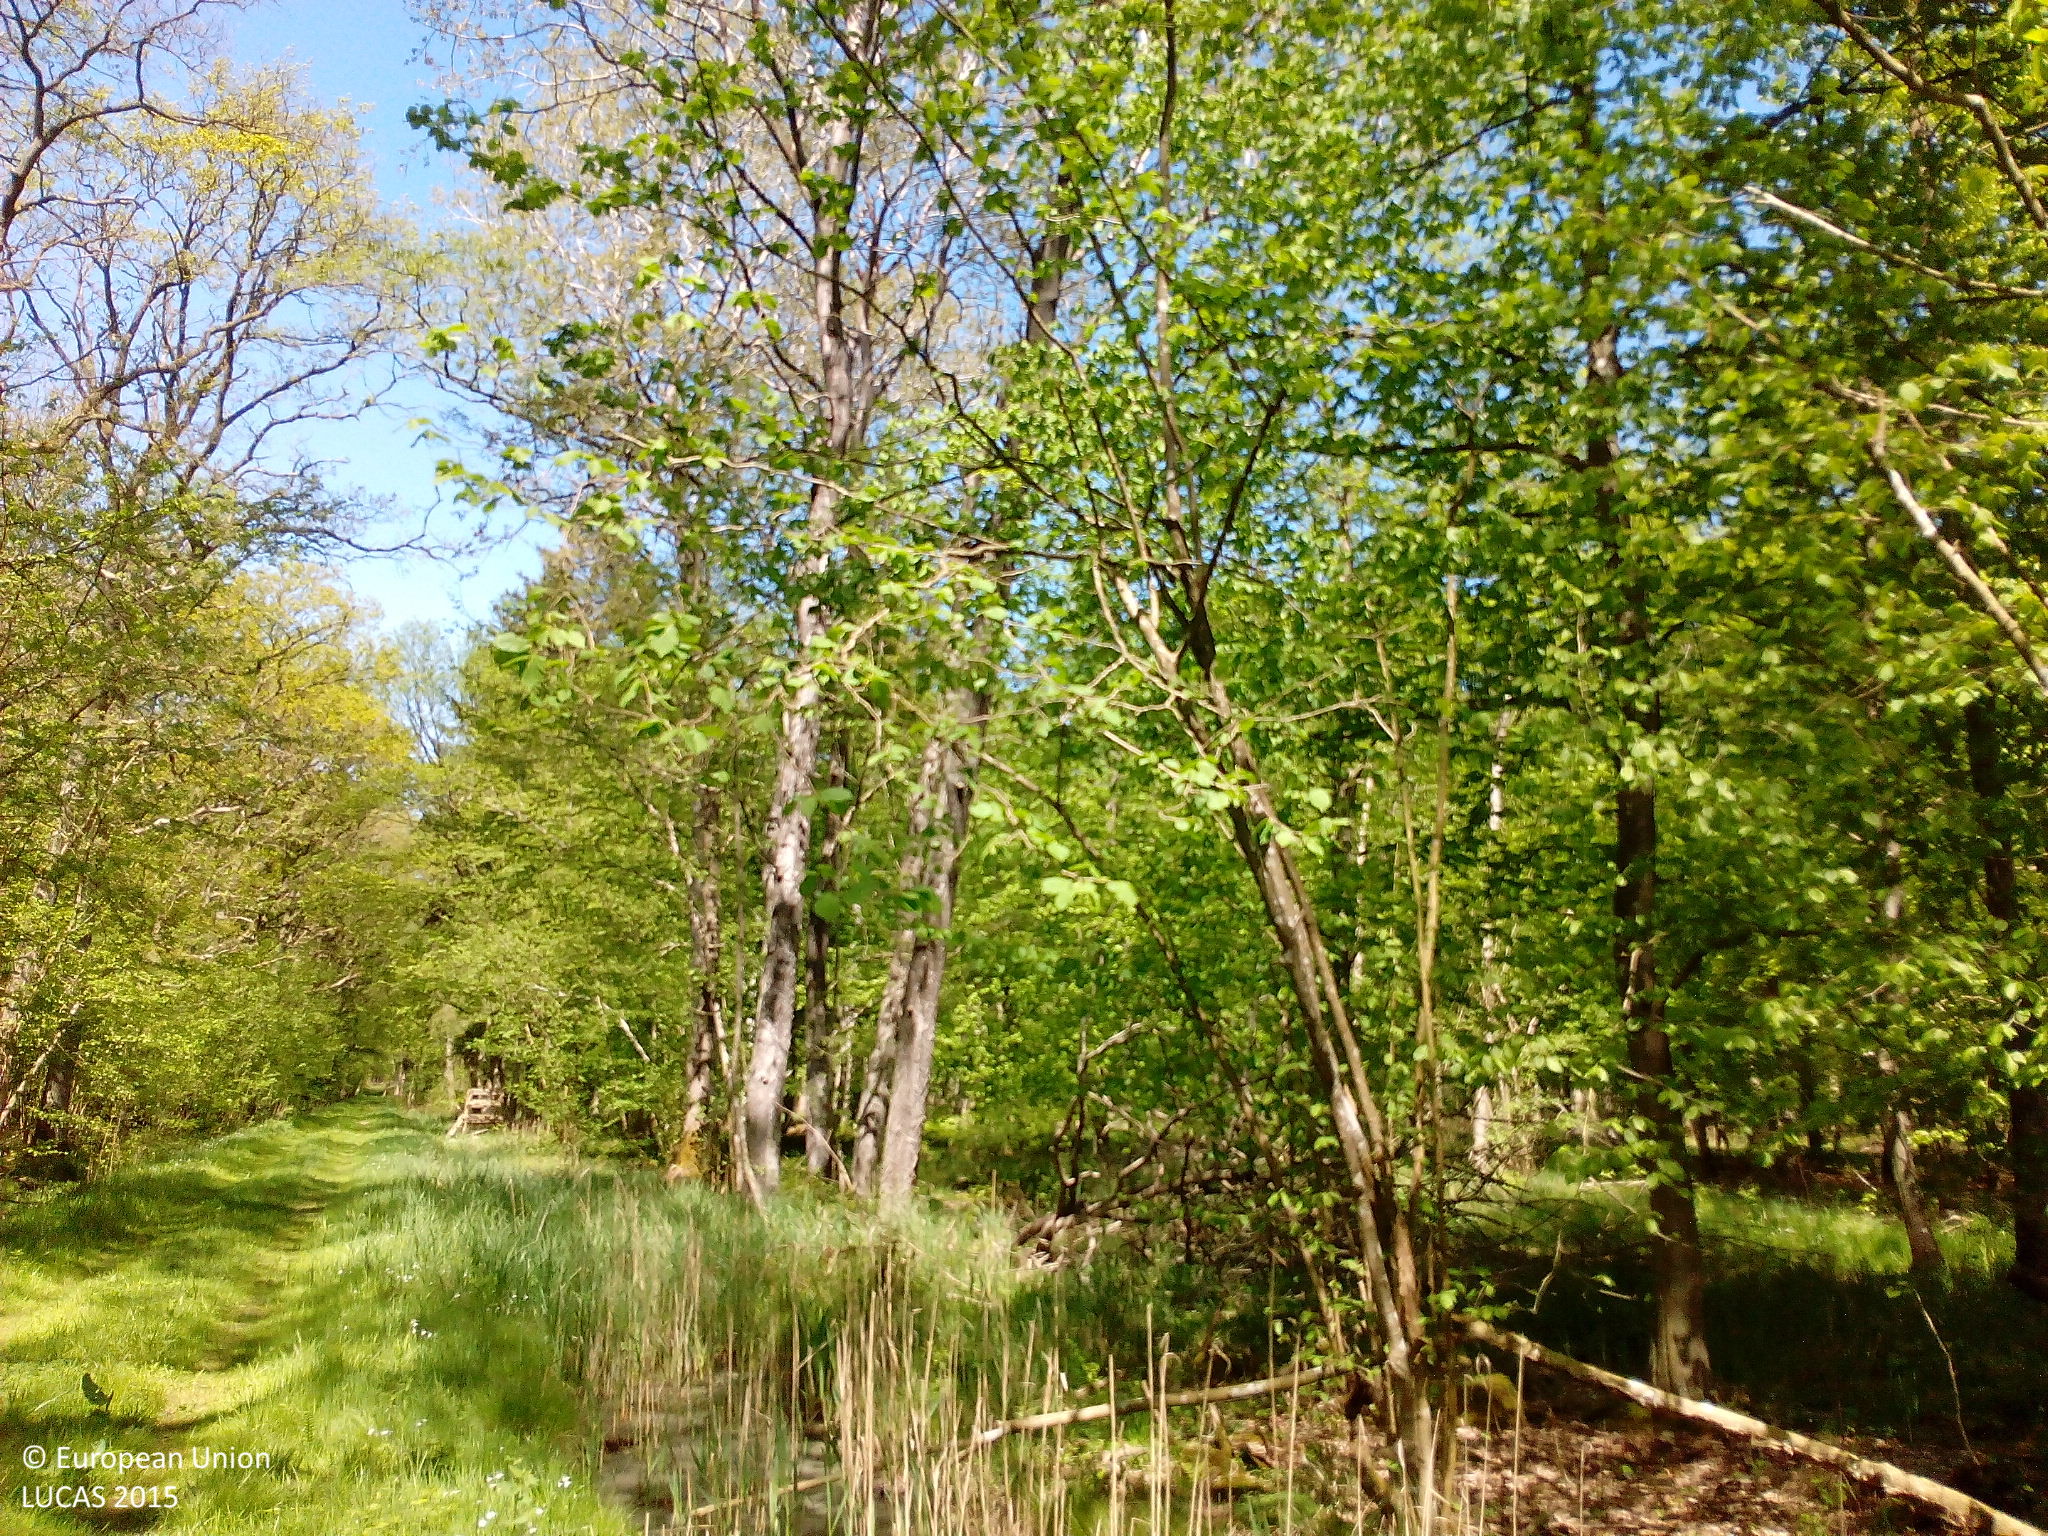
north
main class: Woodland
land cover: Broadleaved woodland
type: mesophytic deciduous forest
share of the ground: > 75 %
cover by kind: broadleaved forest trees 90 %, shrubs 5 %, herbaceous plants 5 %
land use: Forestry
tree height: > 5 m
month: May
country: DE
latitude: 54.3438
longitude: 12.6602
